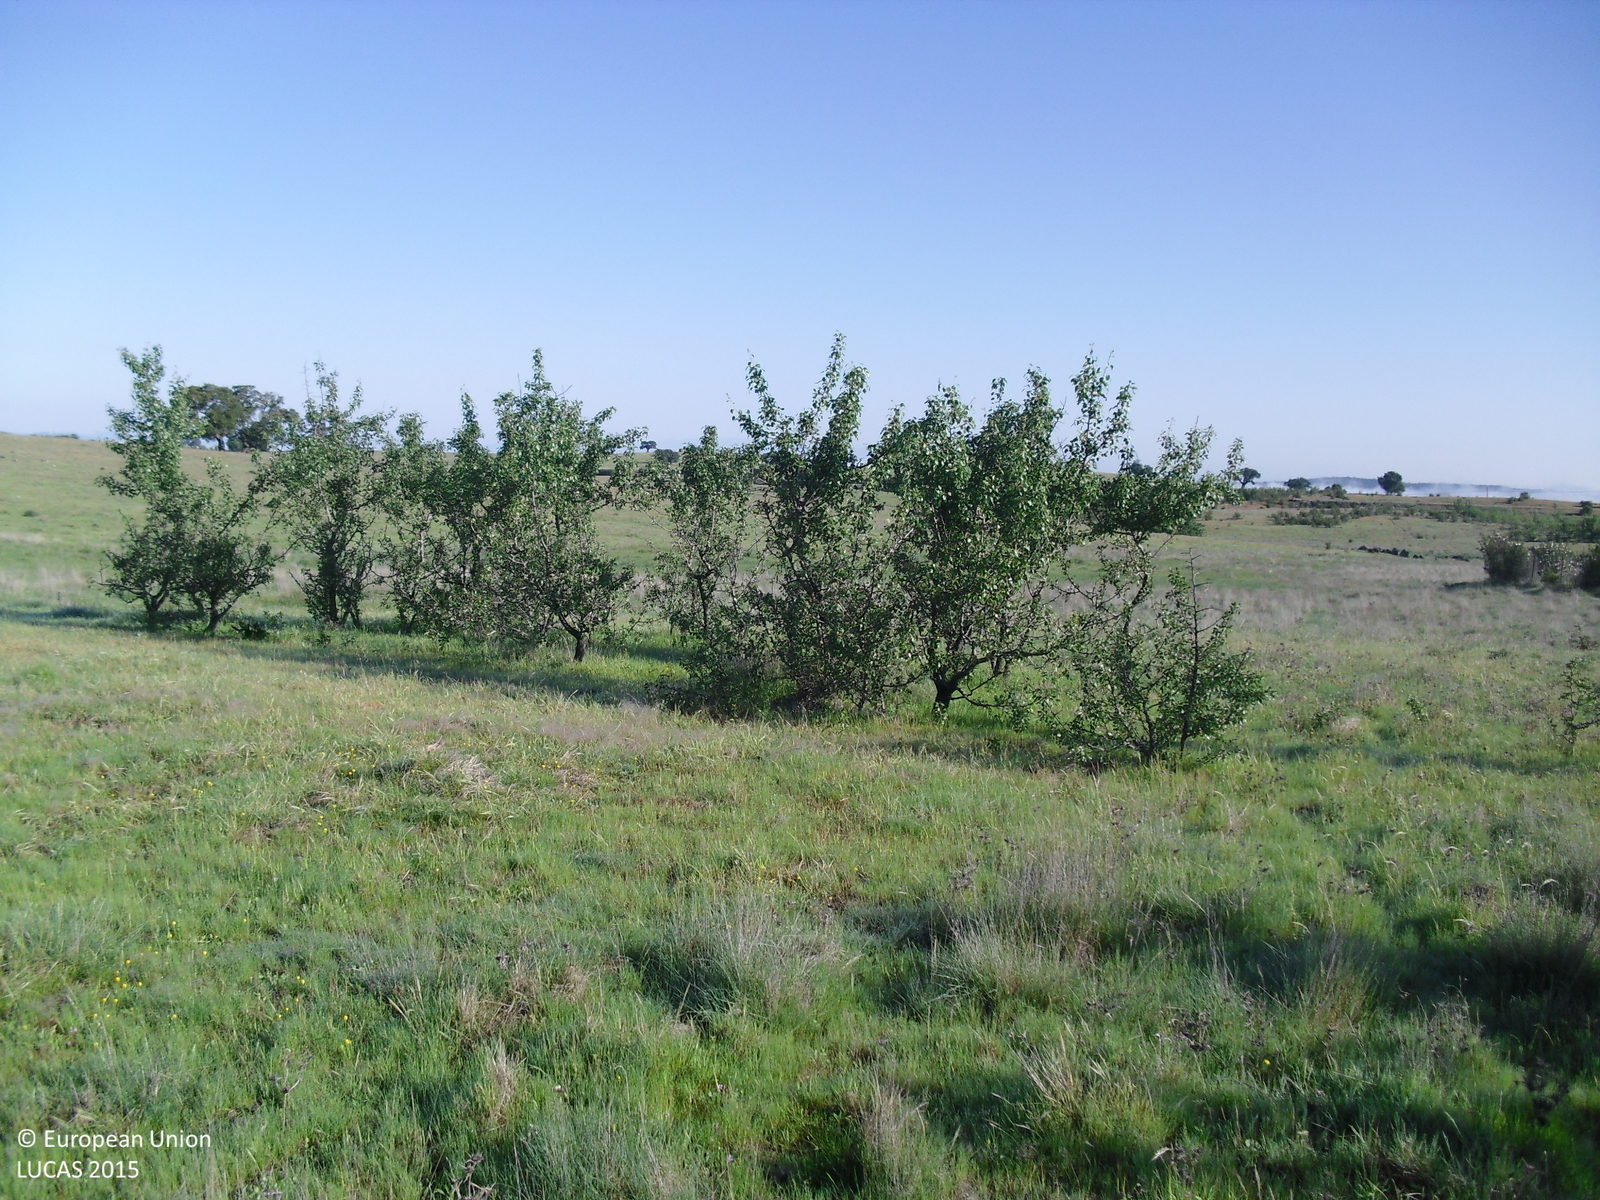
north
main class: Grassland
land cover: Grassland with sparse tree/shrub cover
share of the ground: > 75 %
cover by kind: herbaceous plants 90 %, broadleaved forest trees 5 %, shrubs 5 %
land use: Agriculture (excluding fallow land and kitchen gardens)
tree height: < 5 m
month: April
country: ES
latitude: 39.6284
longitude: -7.4656
